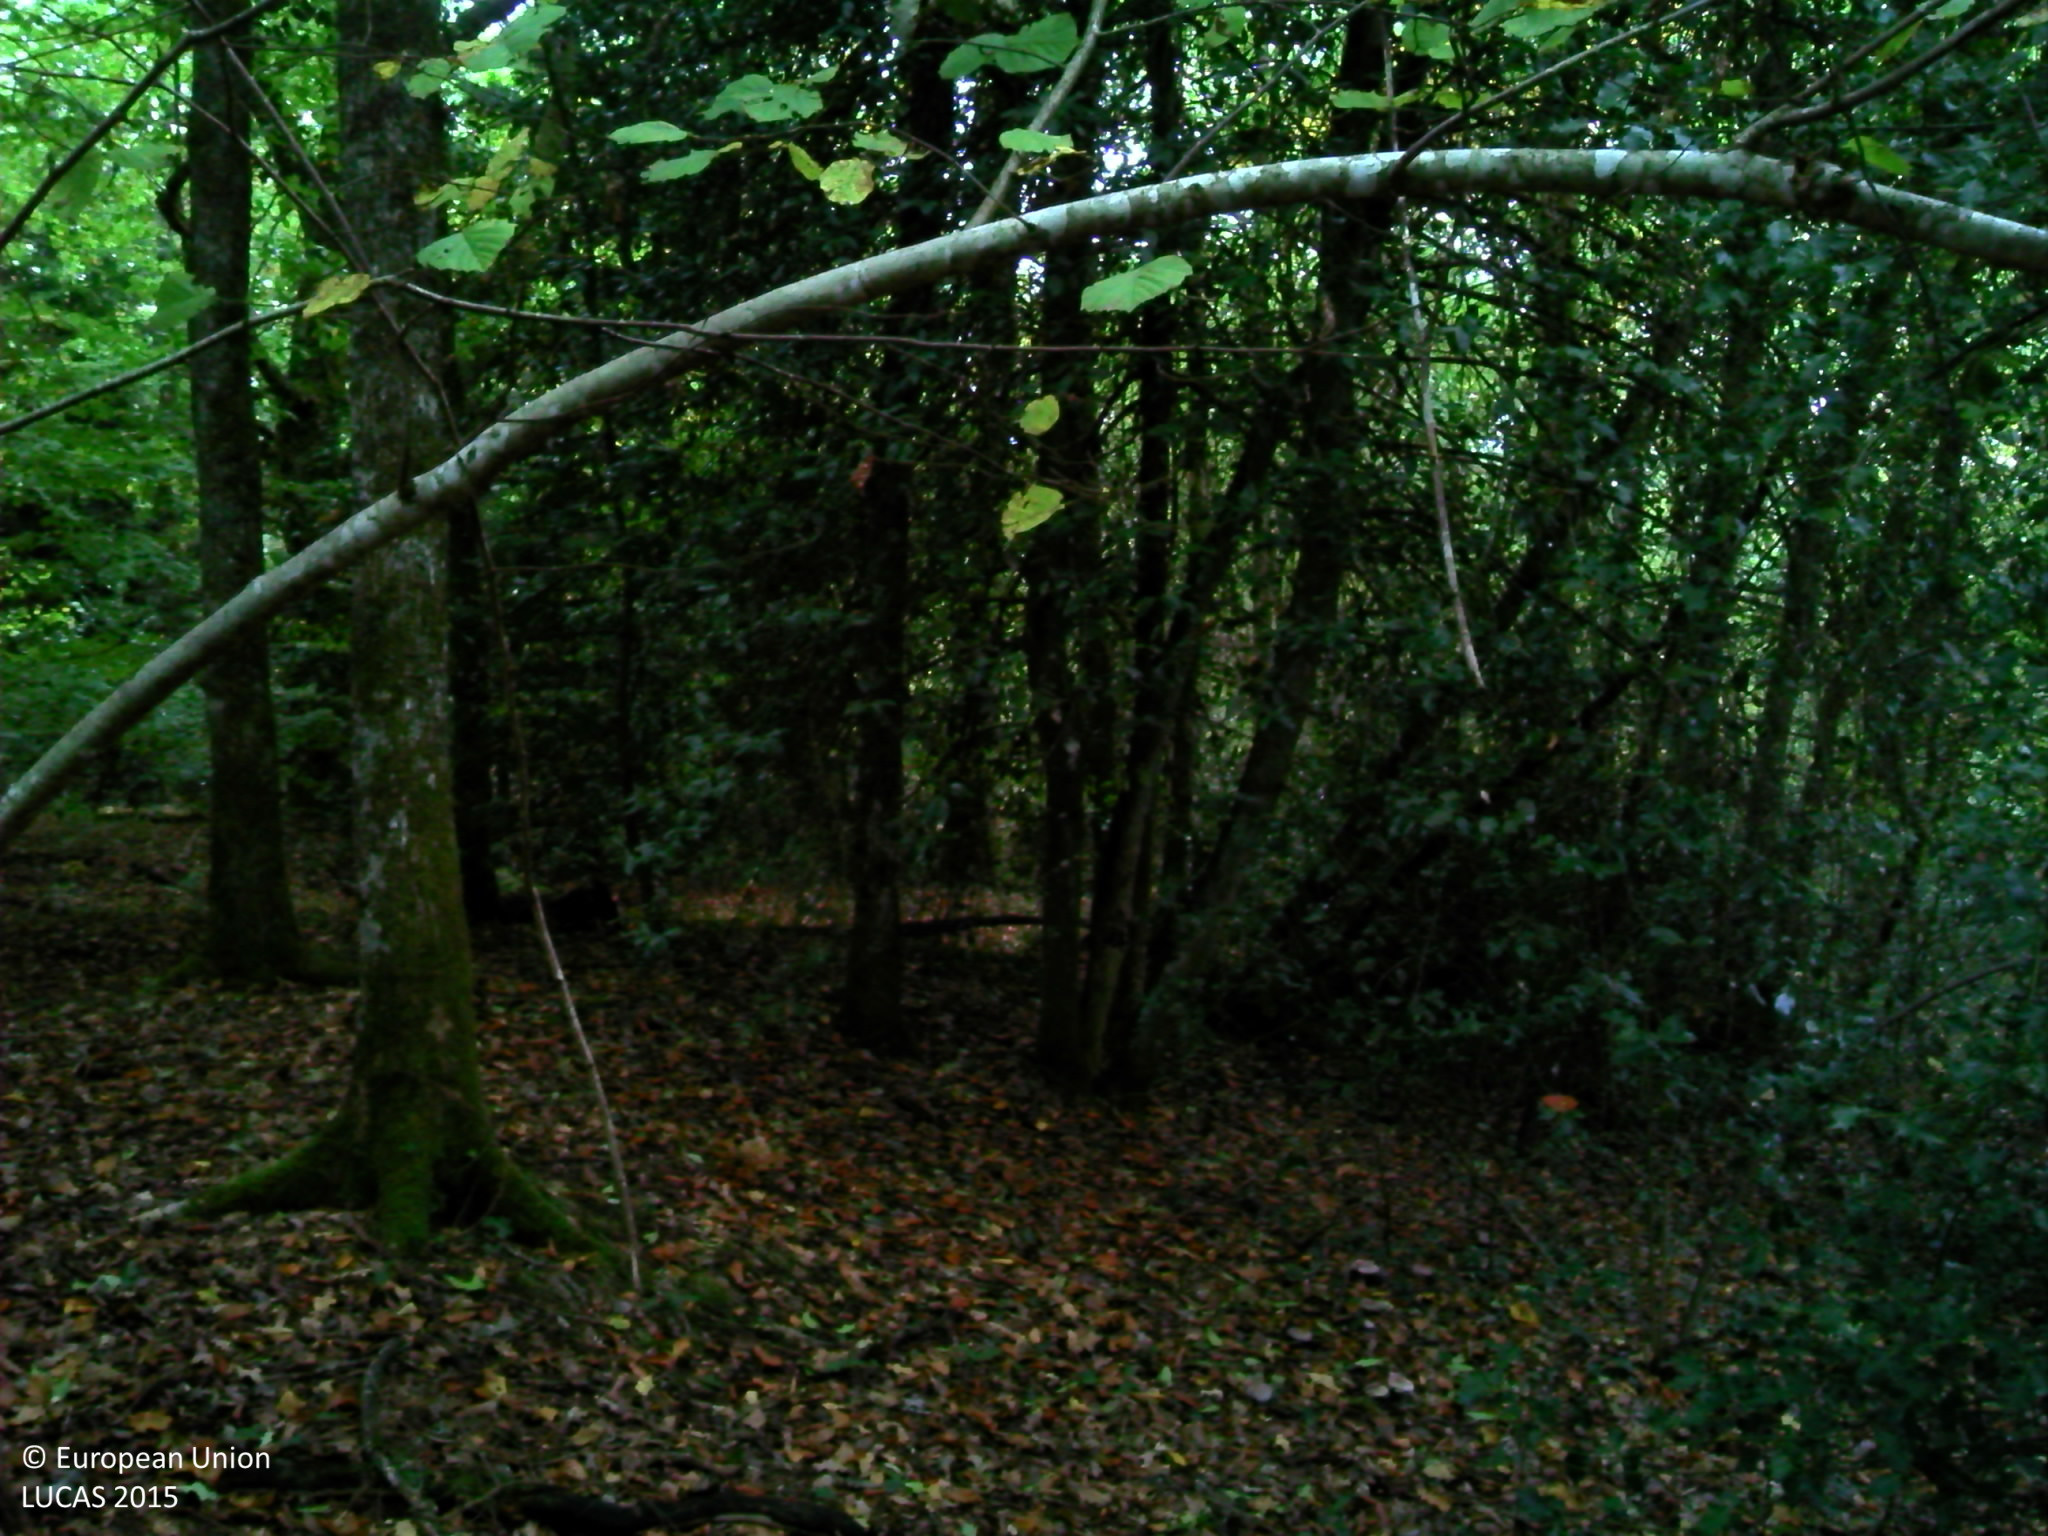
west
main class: Woodland
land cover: Broadleaved woodland
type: beech forest
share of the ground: > 75 %
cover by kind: broadleaved forest trees 85 %, herbaceous plants 15 %
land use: Forestry
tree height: > 5 m
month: October
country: FR
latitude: 45.9124
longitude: 2.8433
